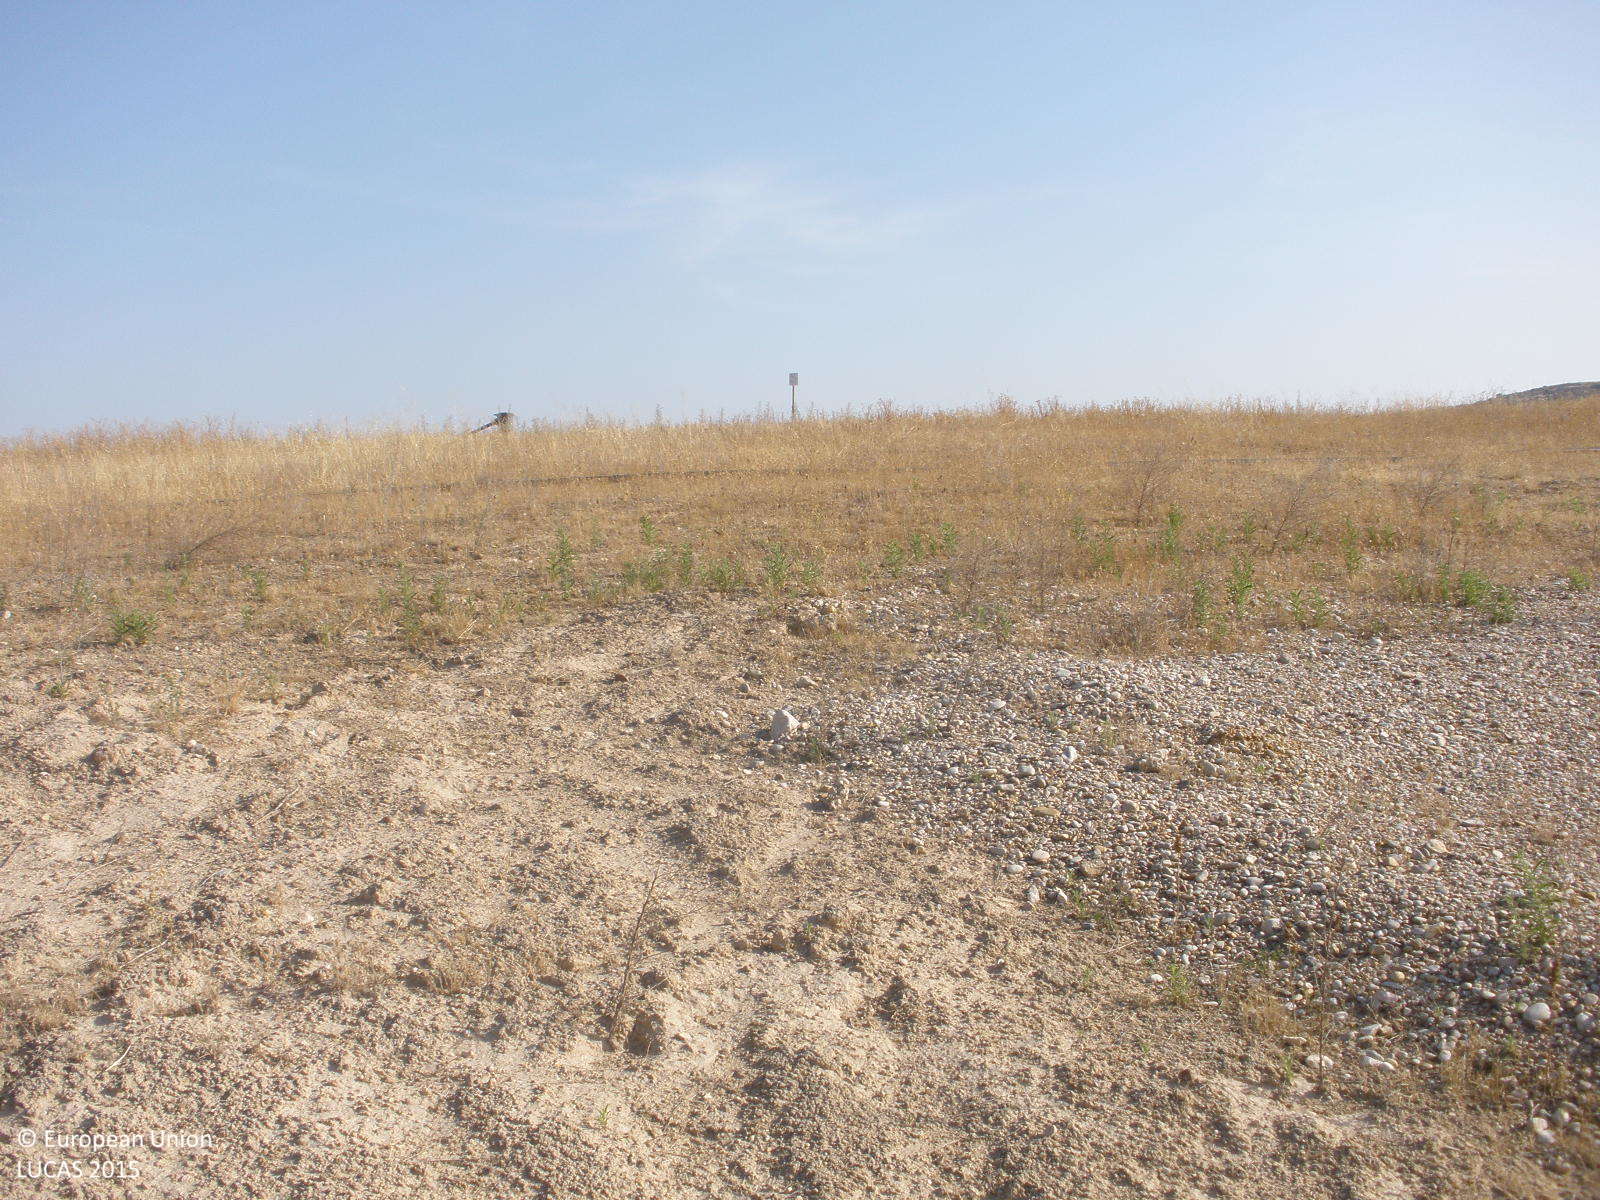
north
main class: Grassland
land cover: Grassland without tree/shrub cover
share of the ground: 50 - 75 %
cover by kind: herbaceous plants 70 %, consolidated bare surface 30 %
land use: Waste treatment
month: July
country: ES
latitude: 40.0894
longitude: -3.4356
